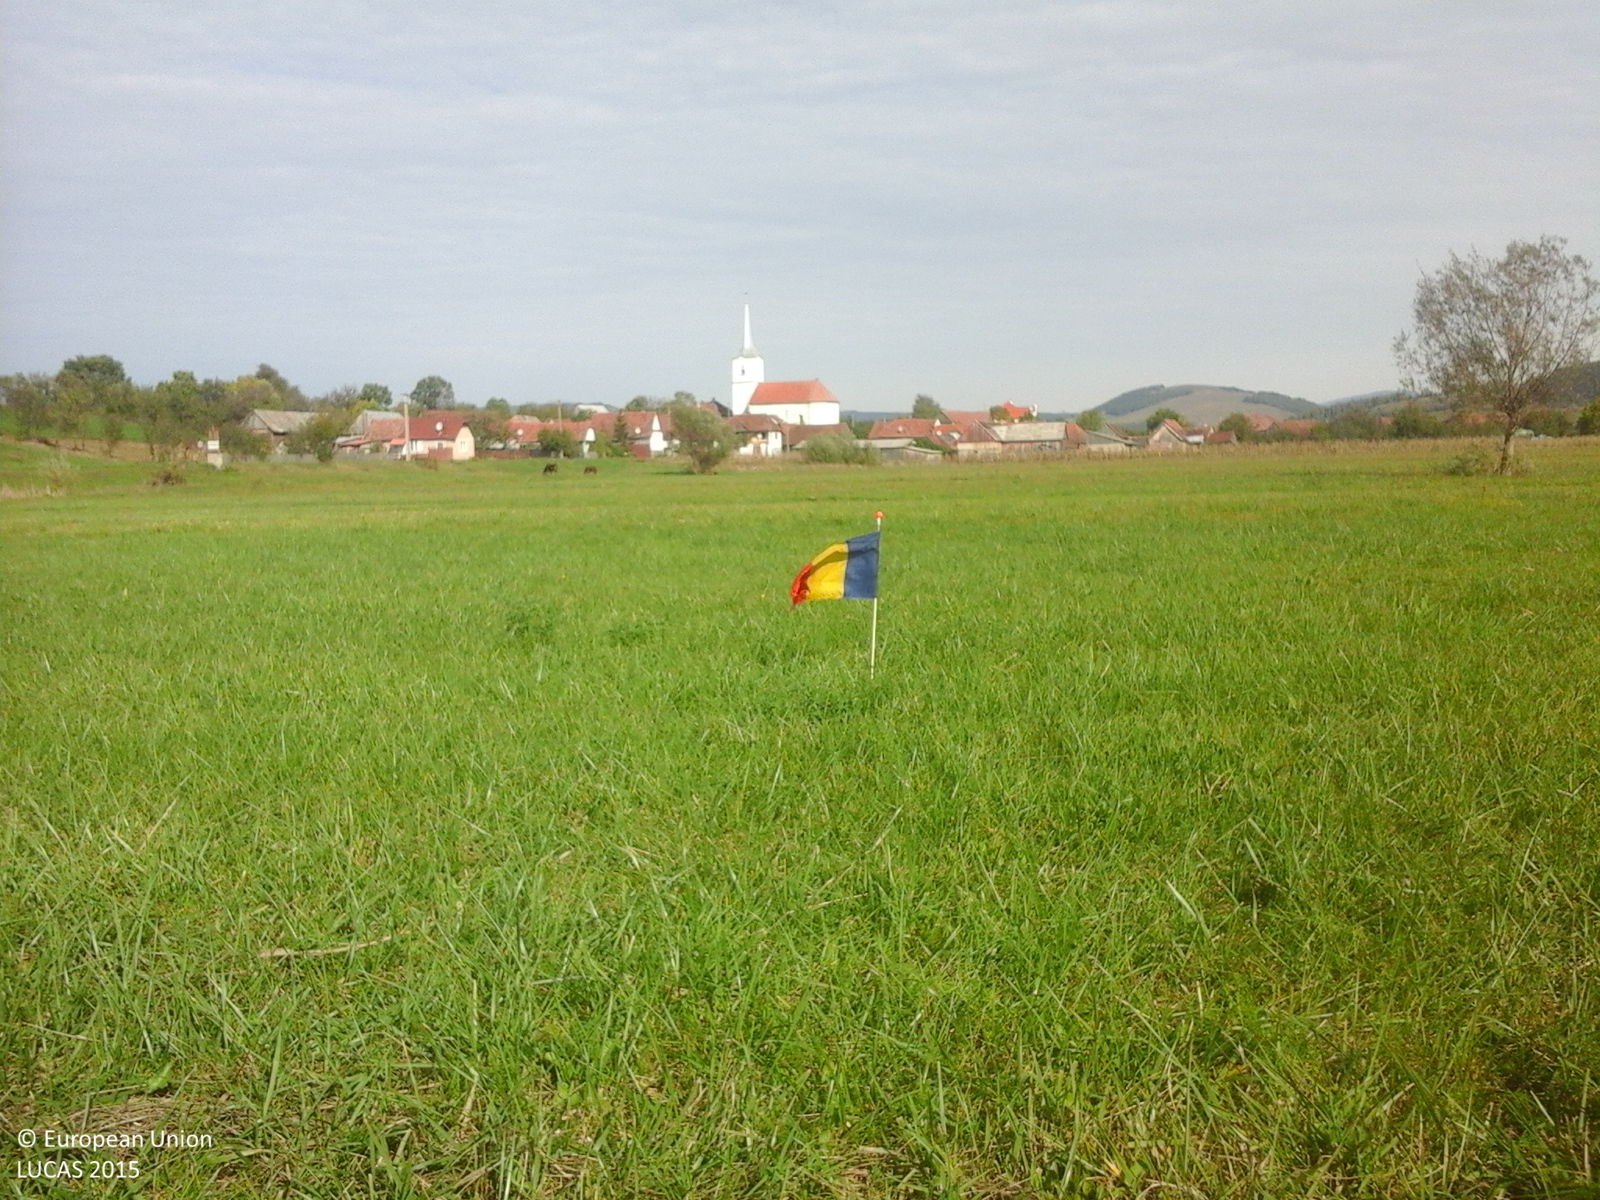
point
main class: Grassland
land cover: Grassland without tree/shrub cover
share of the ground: > 75 %
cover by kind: herbaceous plants 100 %
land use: Agriculture (excluding fallow land and kitchen gardens)
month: October
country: RO
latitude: 46.2011
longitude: 25.3830
